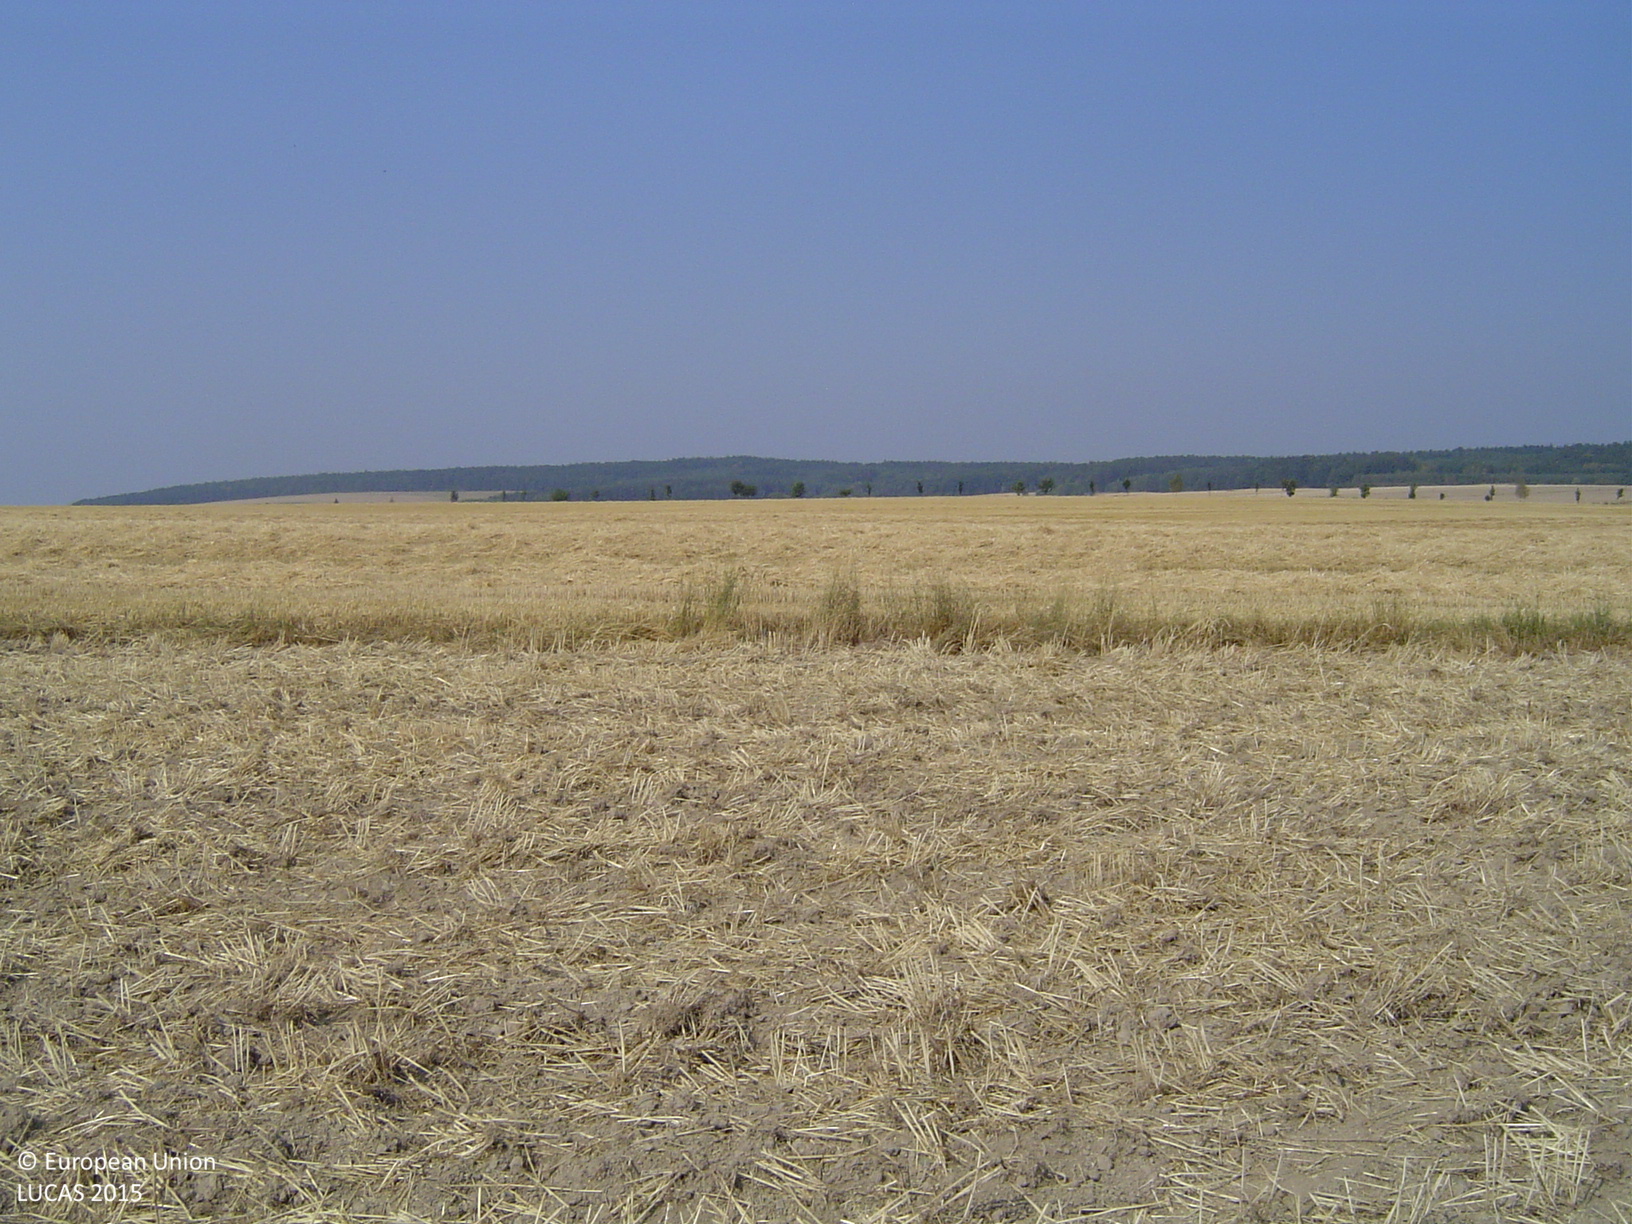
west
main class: Cropland
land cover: Common wheat
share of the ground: 50 - 75 %
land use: Agriculture (excluding fallow land and kitchen gardens)
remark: Harvested field
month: August
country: CZ
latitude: 50.0388
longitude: 14.0920
